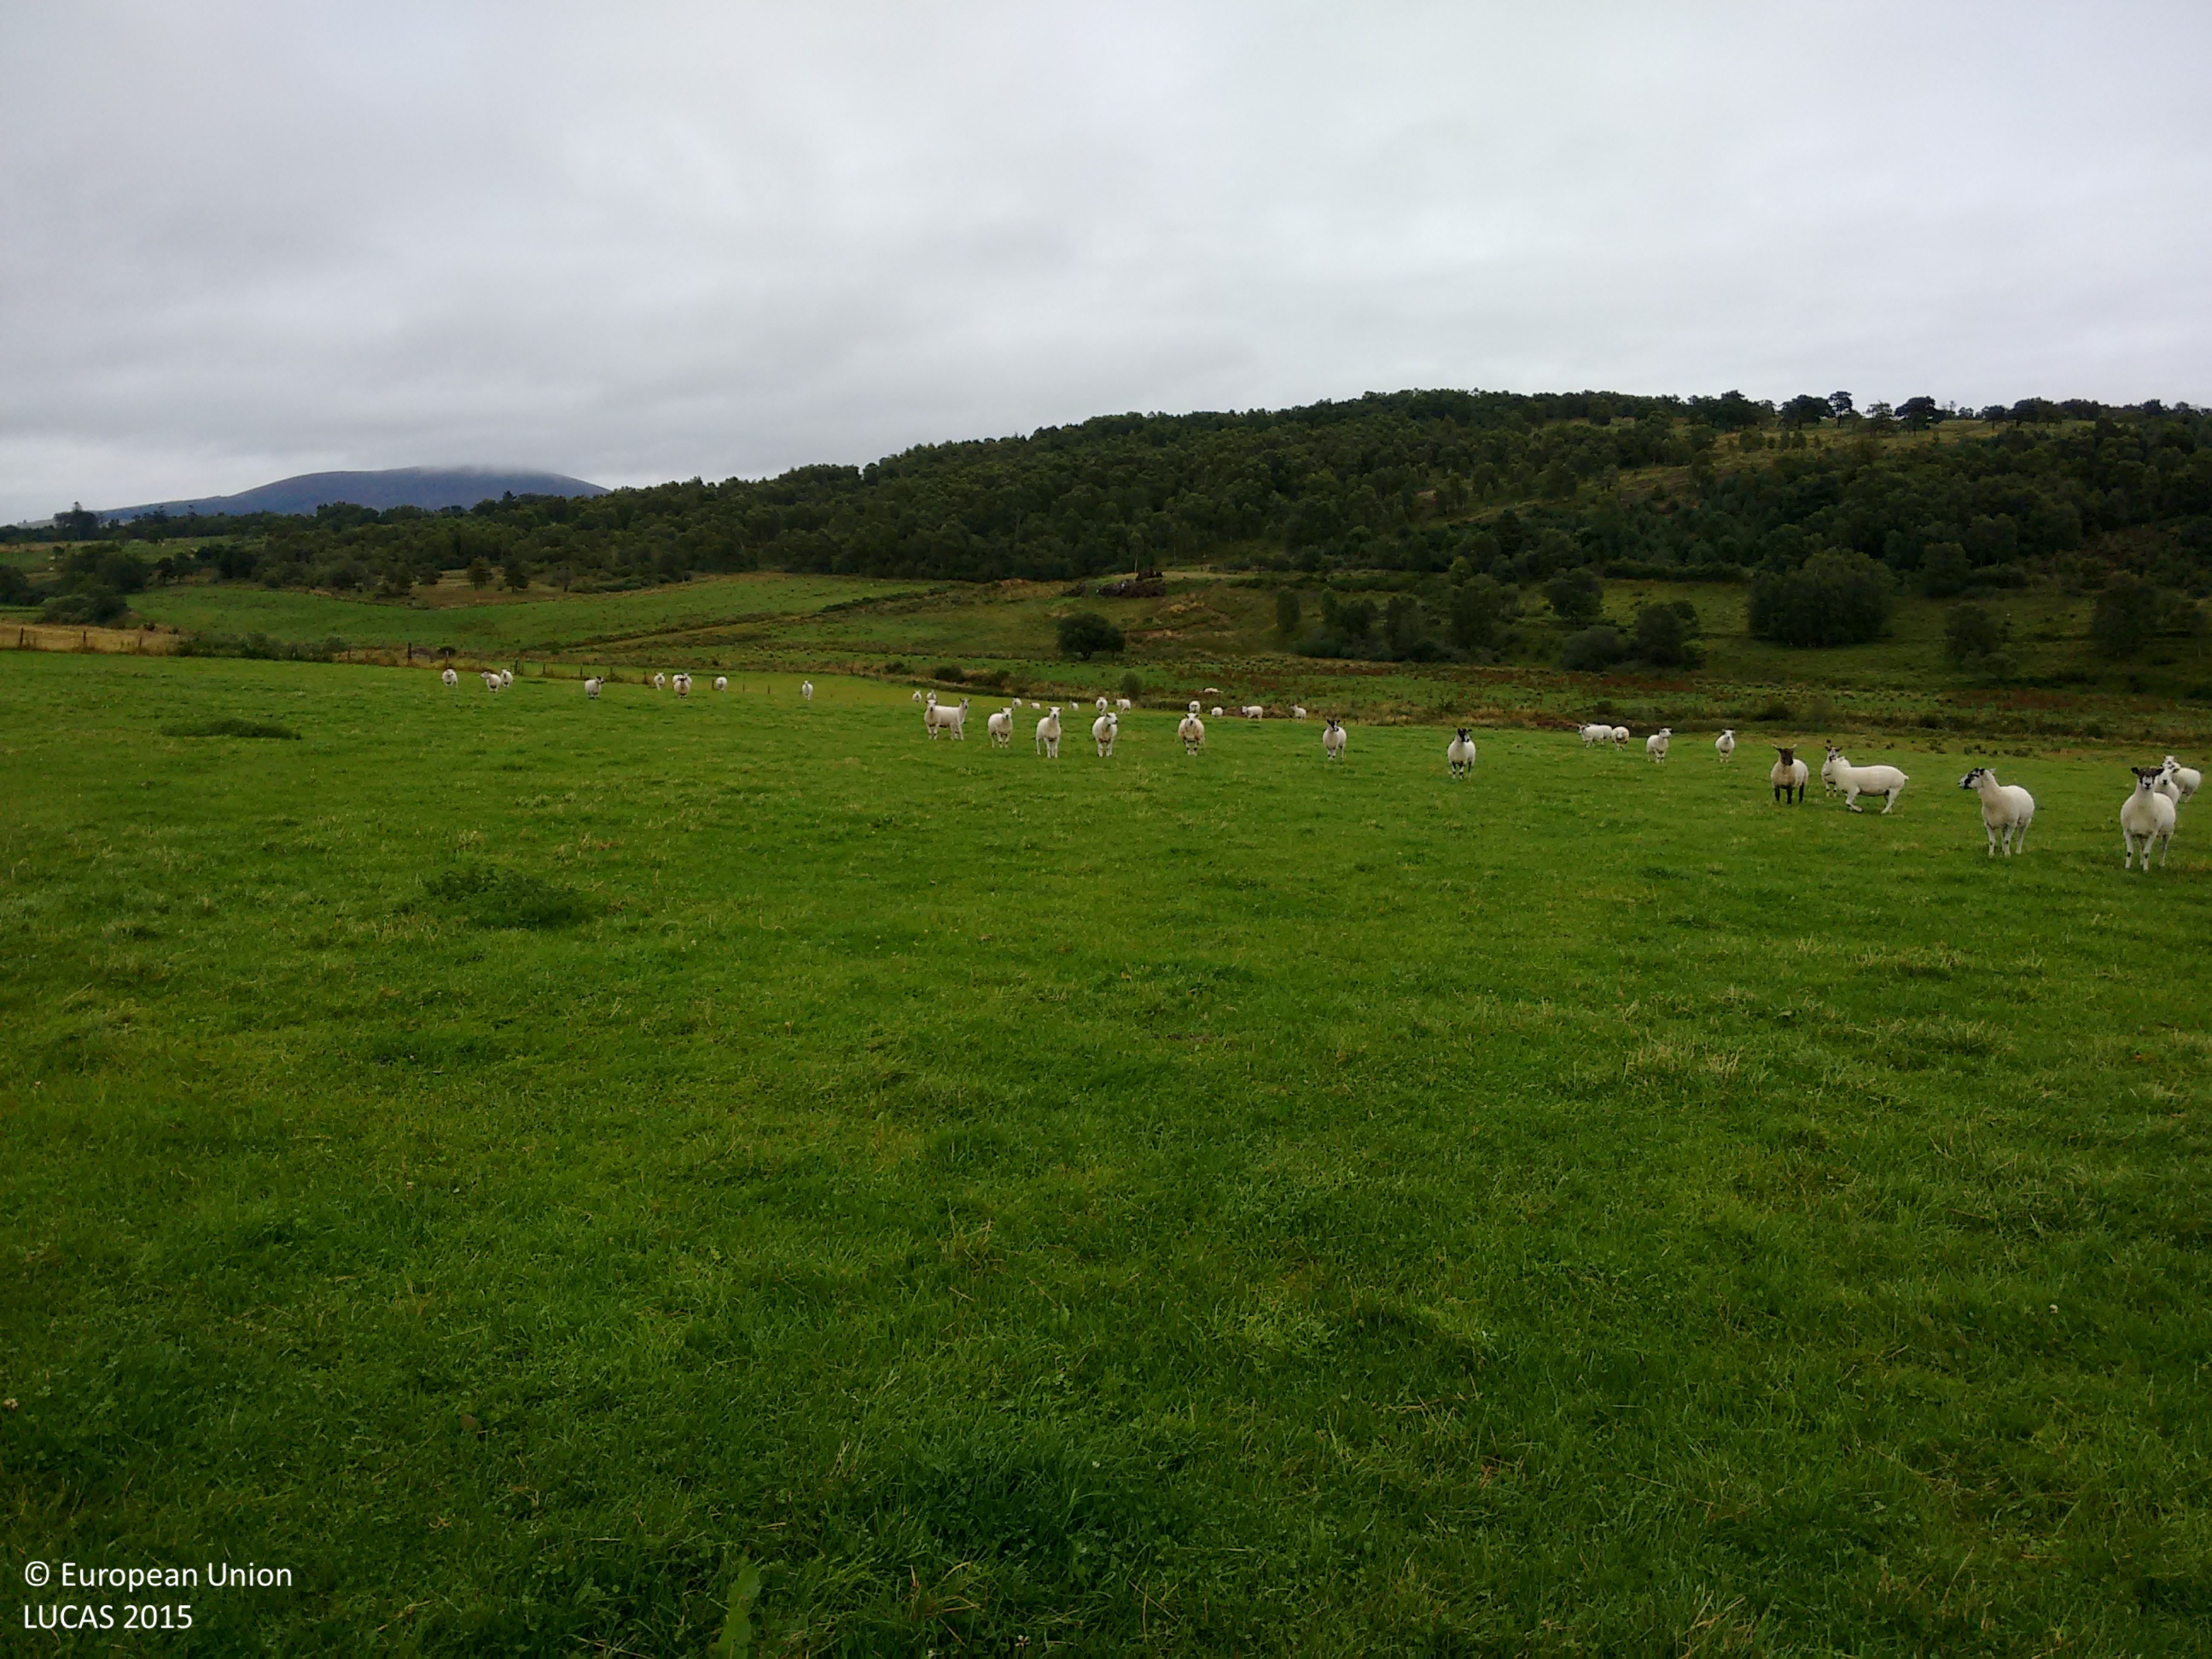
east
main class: Grassland
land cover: Grassland without tree/shrub cover
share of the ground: > 75 %
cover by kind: herbaceous plants 100 %
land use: Agriculture (excluding fallow land and kitchen gardens)
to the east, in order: Grassland without tree/shrub cover; Fences; Electric lines; Grassland without tree/shrub cover; Fences; Grassland without tree/shrub cover; Fences; Grass margins; Inland fresh running water; Spontaneously vegetated surfaces; Fences; Grassland without tree/shrub cover
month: September
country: GB
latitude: 57.5600
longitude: -2.8789
